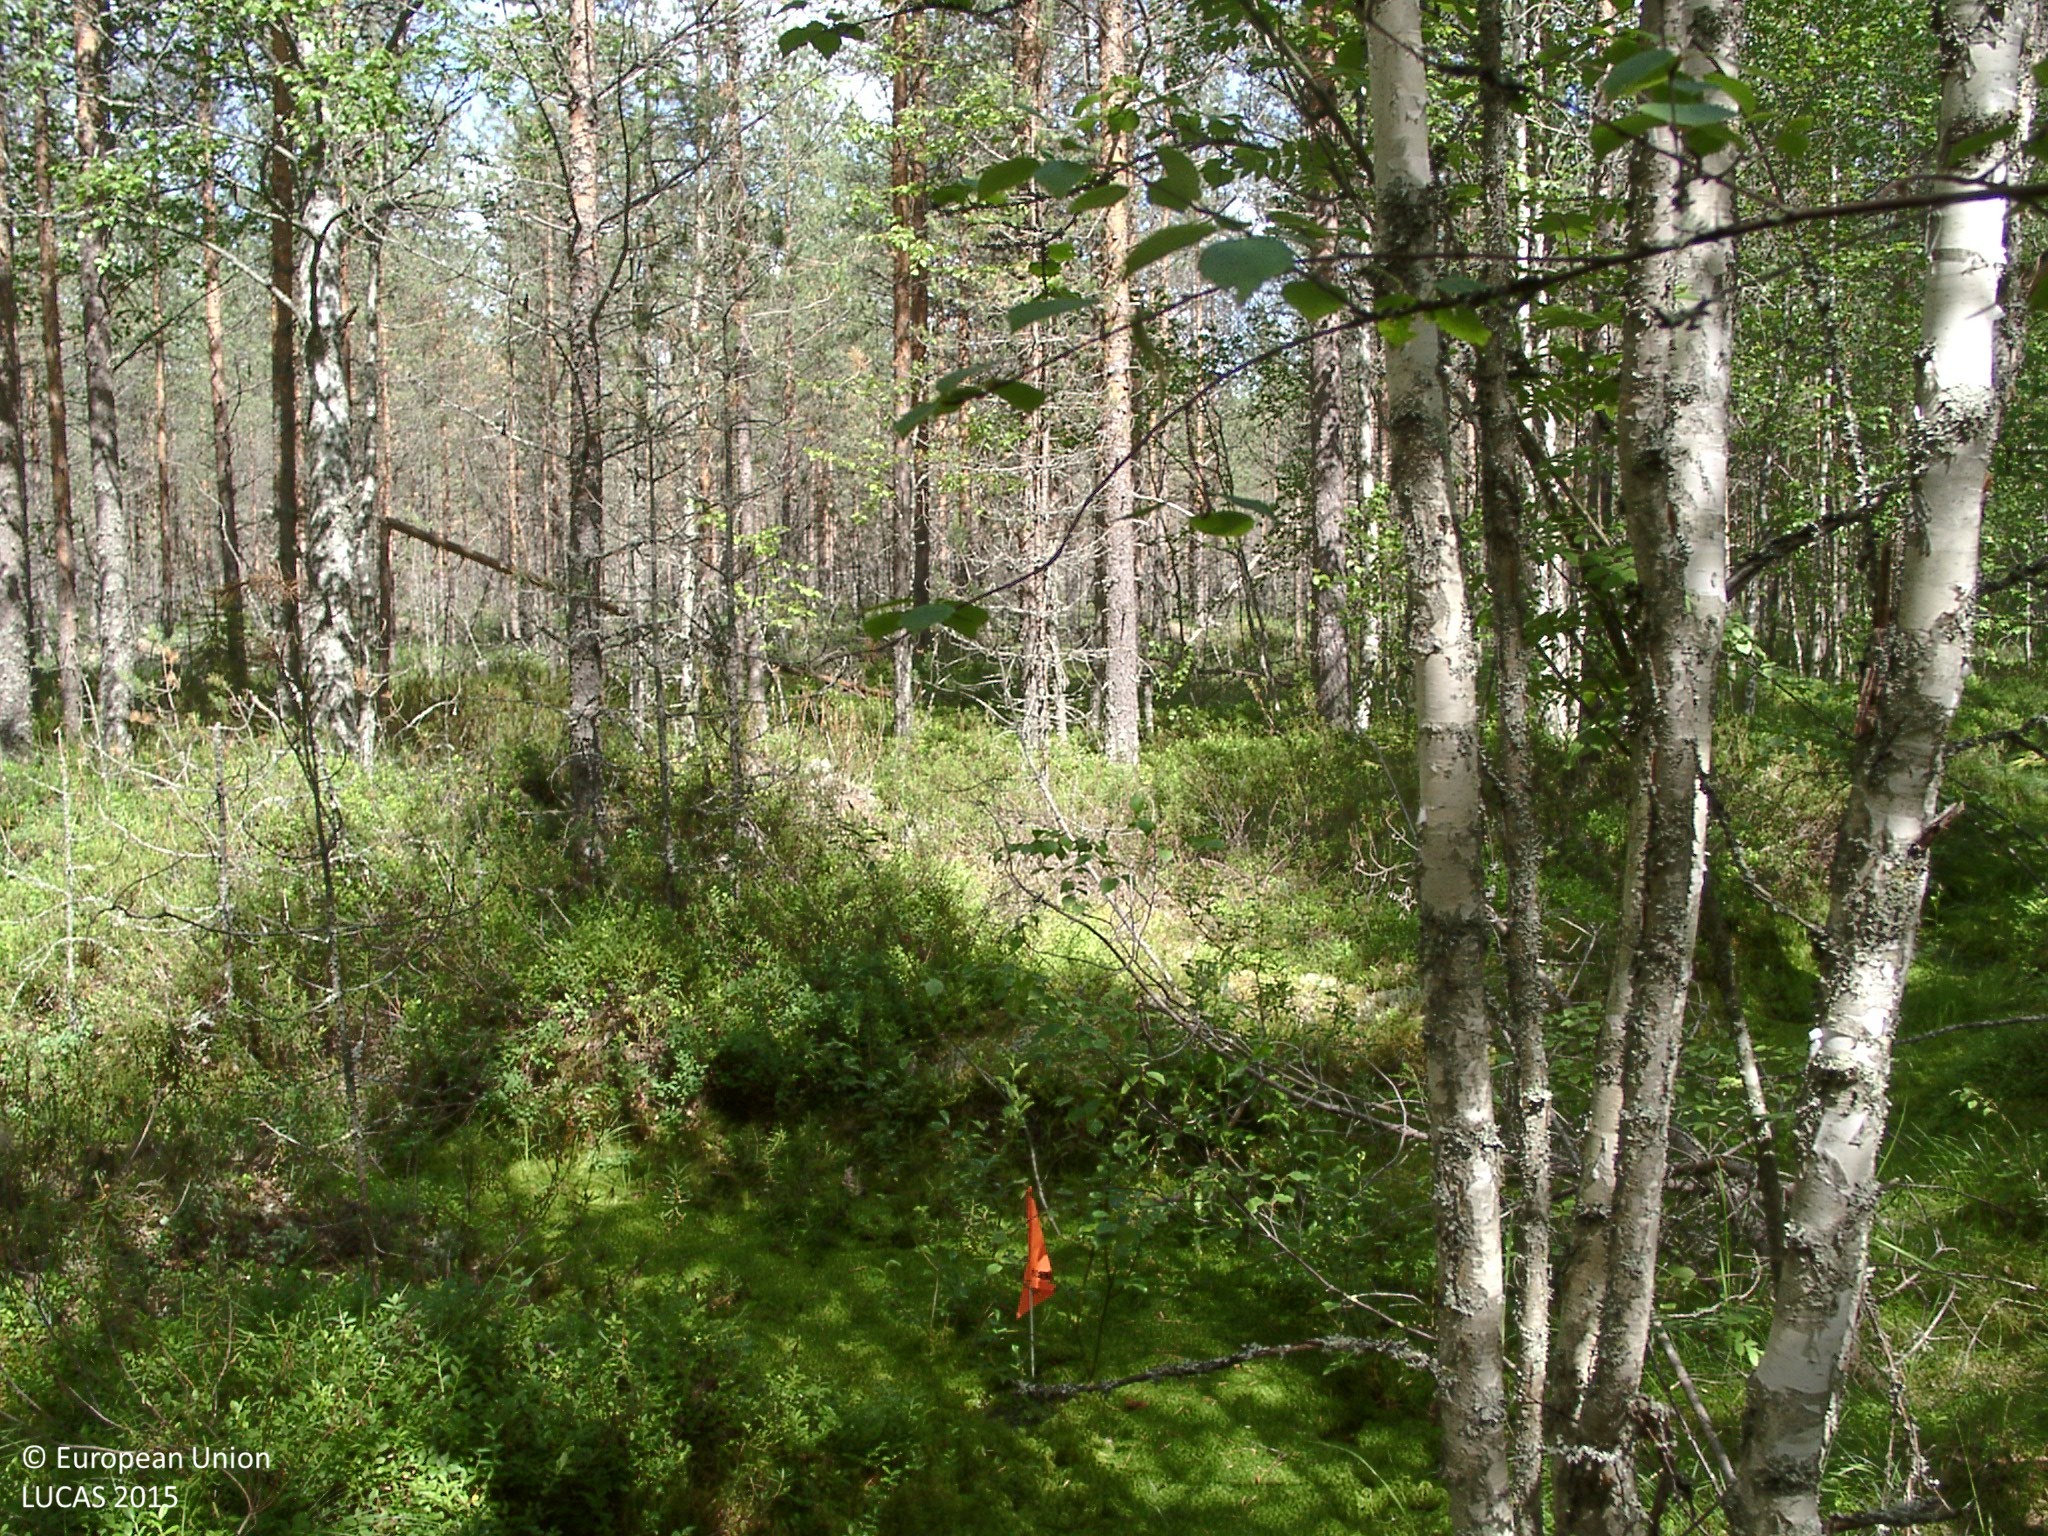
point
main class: Woodland
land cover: Pine dominated coniferous woodland
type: mire and swamp forests
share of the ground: 50 - 75 %
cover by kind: coniferous forest trees 50 %, shrubs 30 %, broadleaved forest trees 15 %, lichens and mosses 5 %
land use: Forestry
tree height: > 5 m
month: July
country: FI
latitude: 62.2785
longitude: 24.9979
